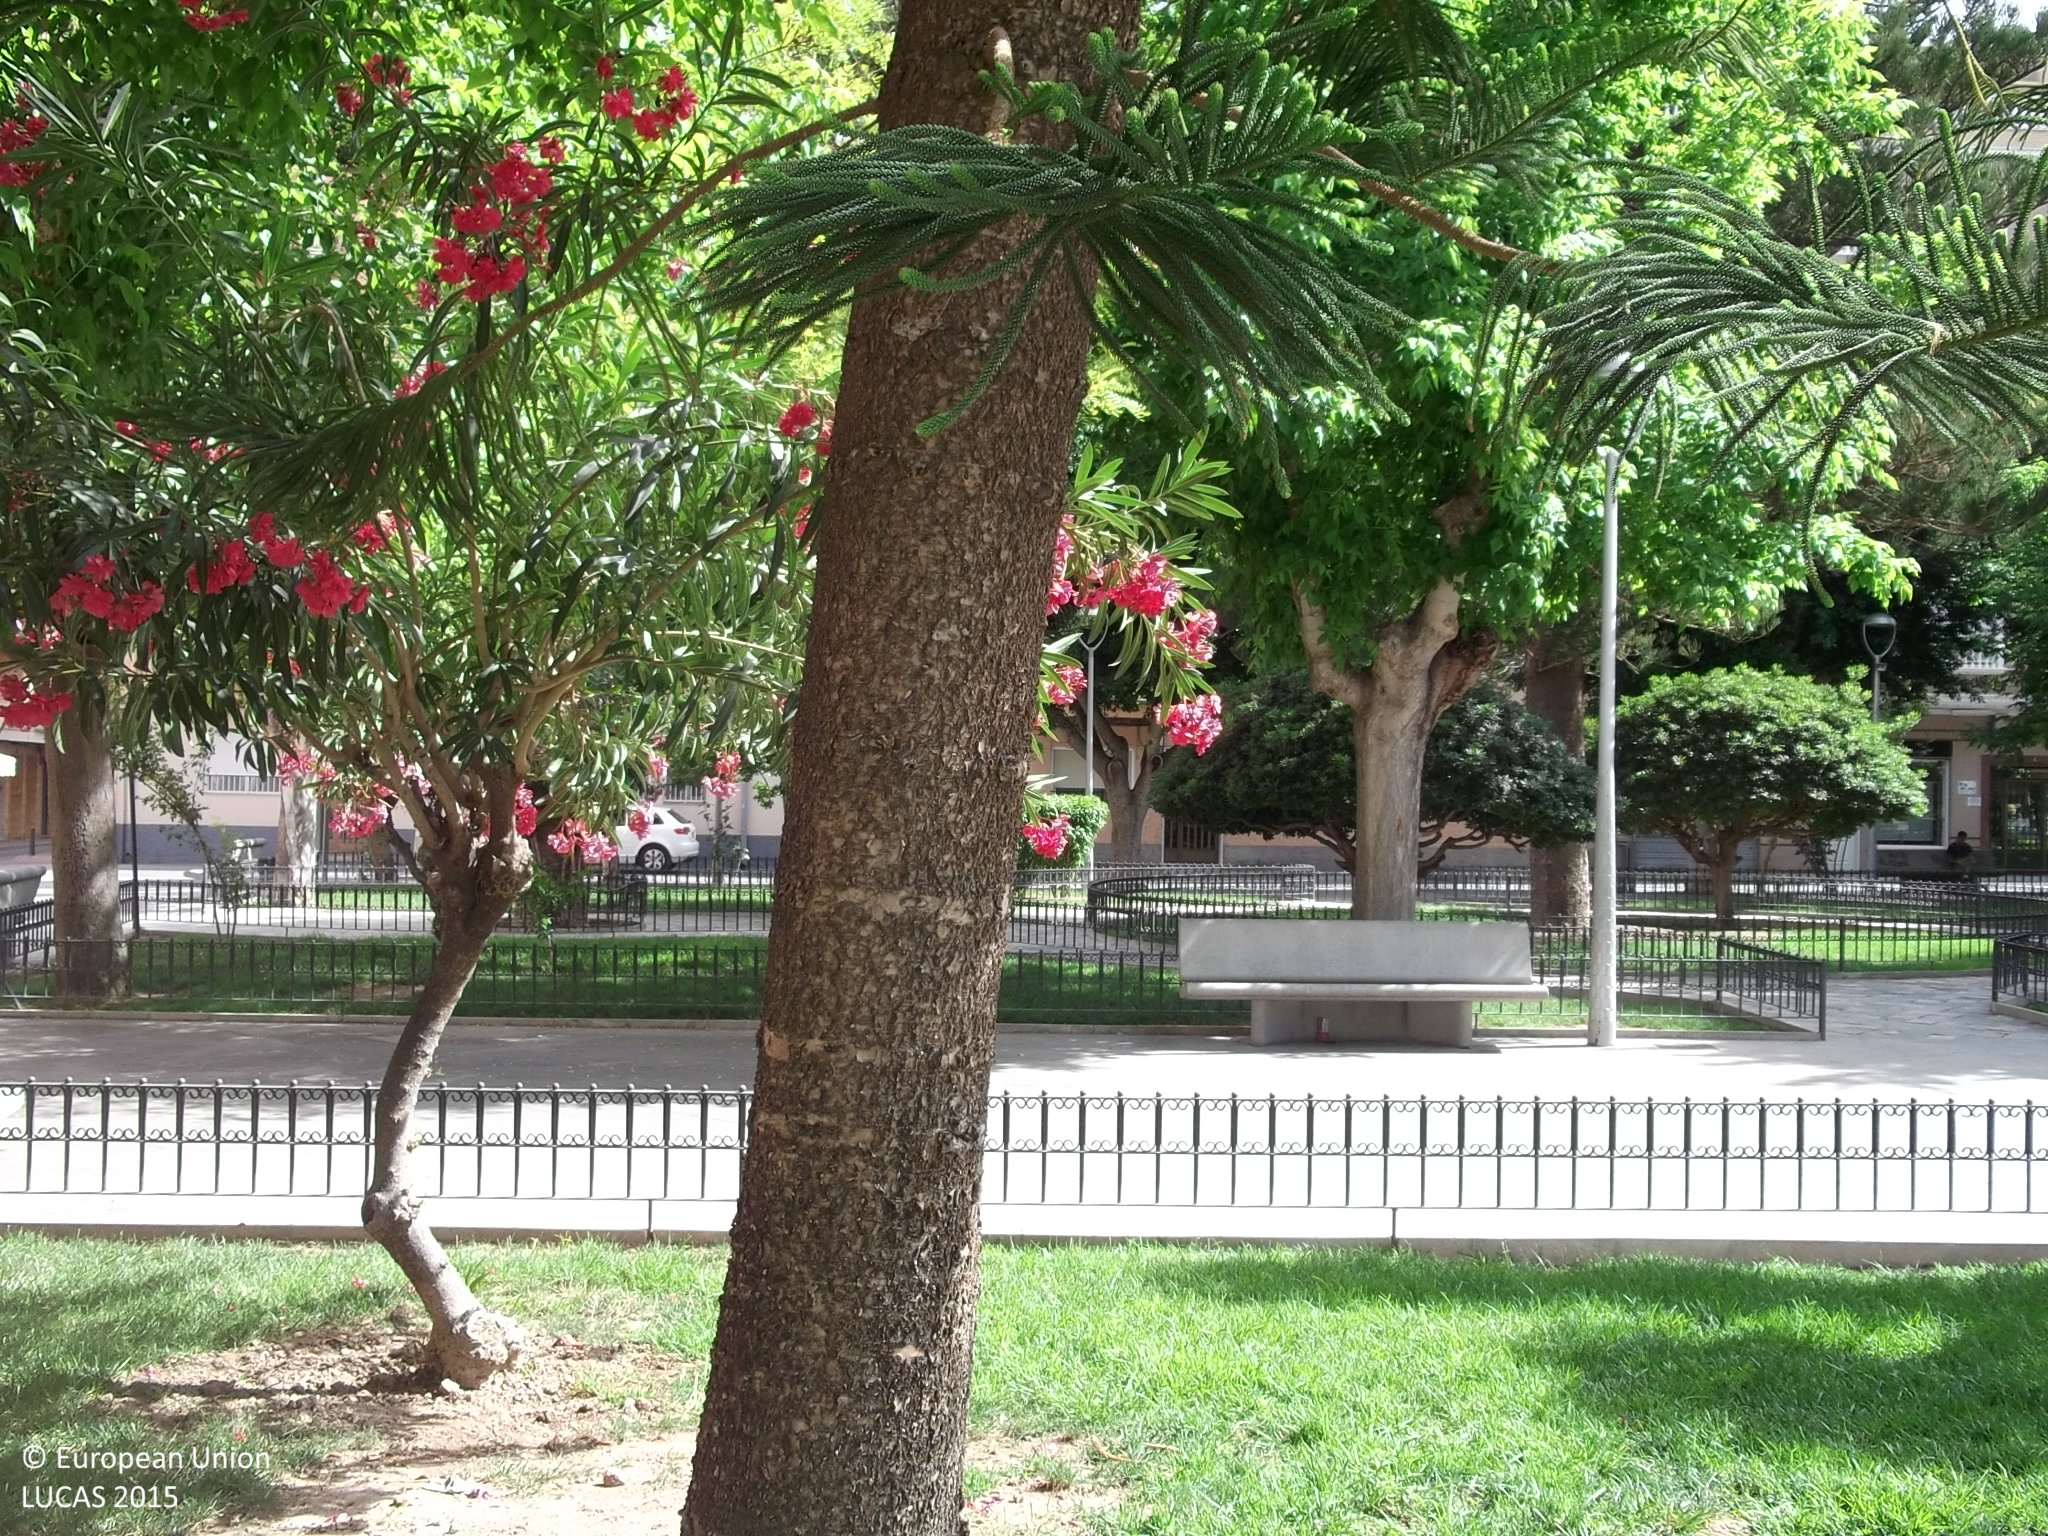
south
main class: Woodland
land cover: Broadleaved woodland
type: broadleaved evergreen forest
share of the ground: 50 - 75 %
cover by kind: broadleaved forest trees 50 %
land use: Amenities, museums, leisure
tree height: > 5 m
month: May
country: ES
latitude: 38.1269
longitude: -0.8788
